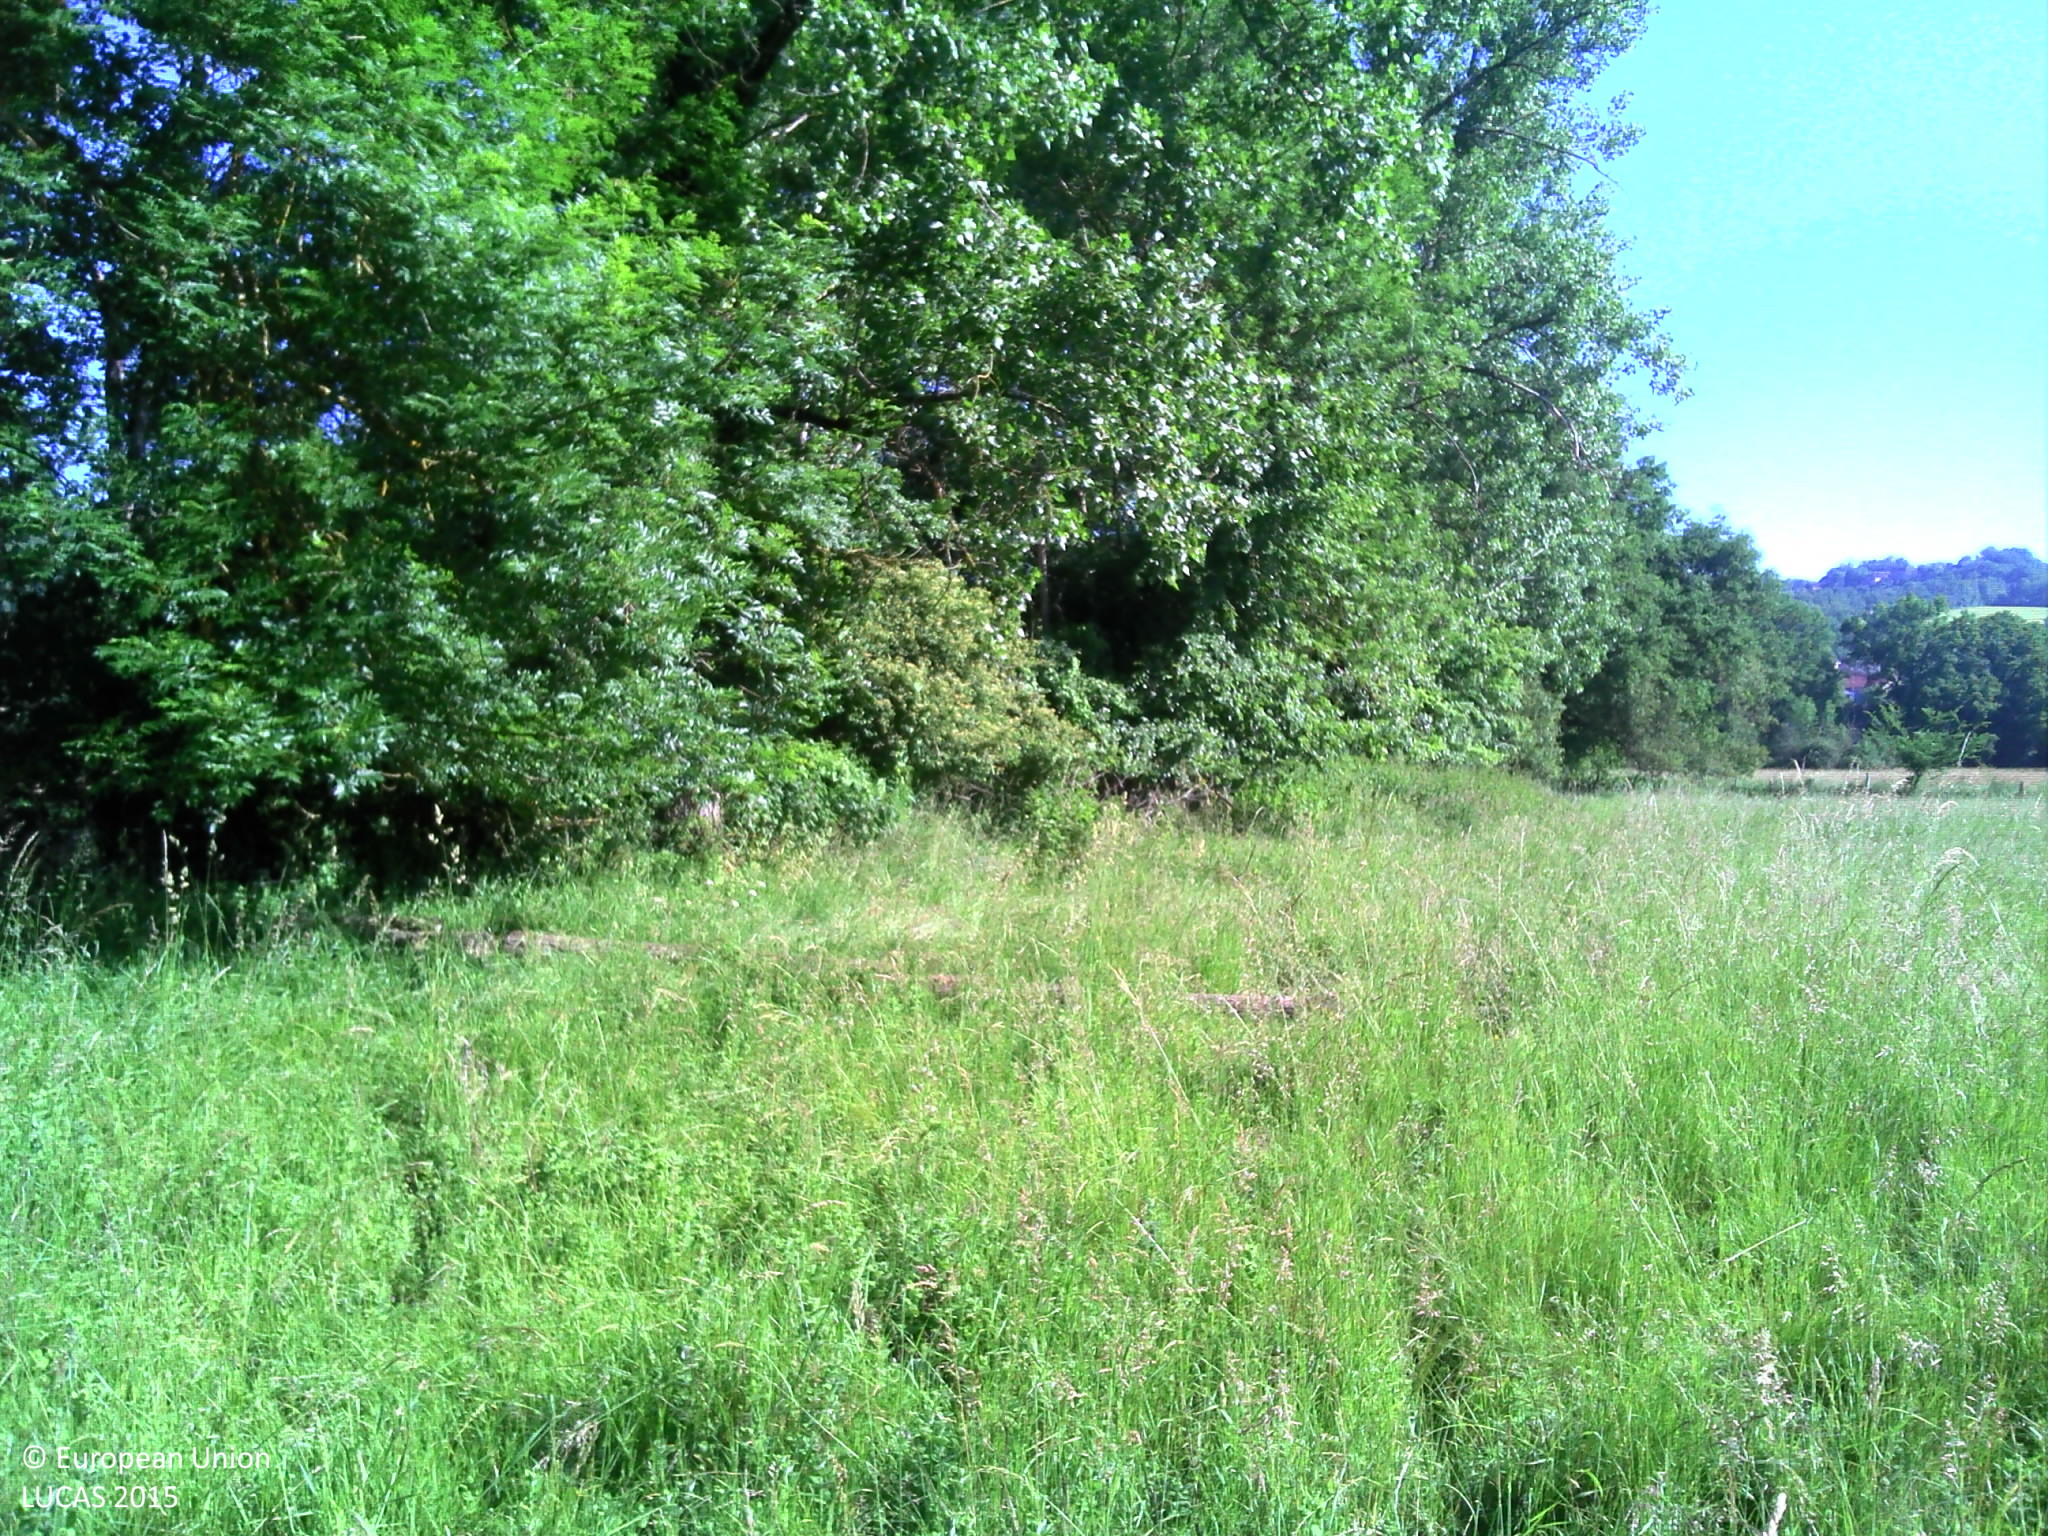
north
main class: Grassland
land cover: Grassland without tree/shrub cover
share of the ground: > 75 %
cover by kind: herbaceous plants 100 %
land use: Agriculture (excluding fallow land and kitchen gardens)
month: May
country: FR
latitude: 44.5971
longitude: 1.9245
